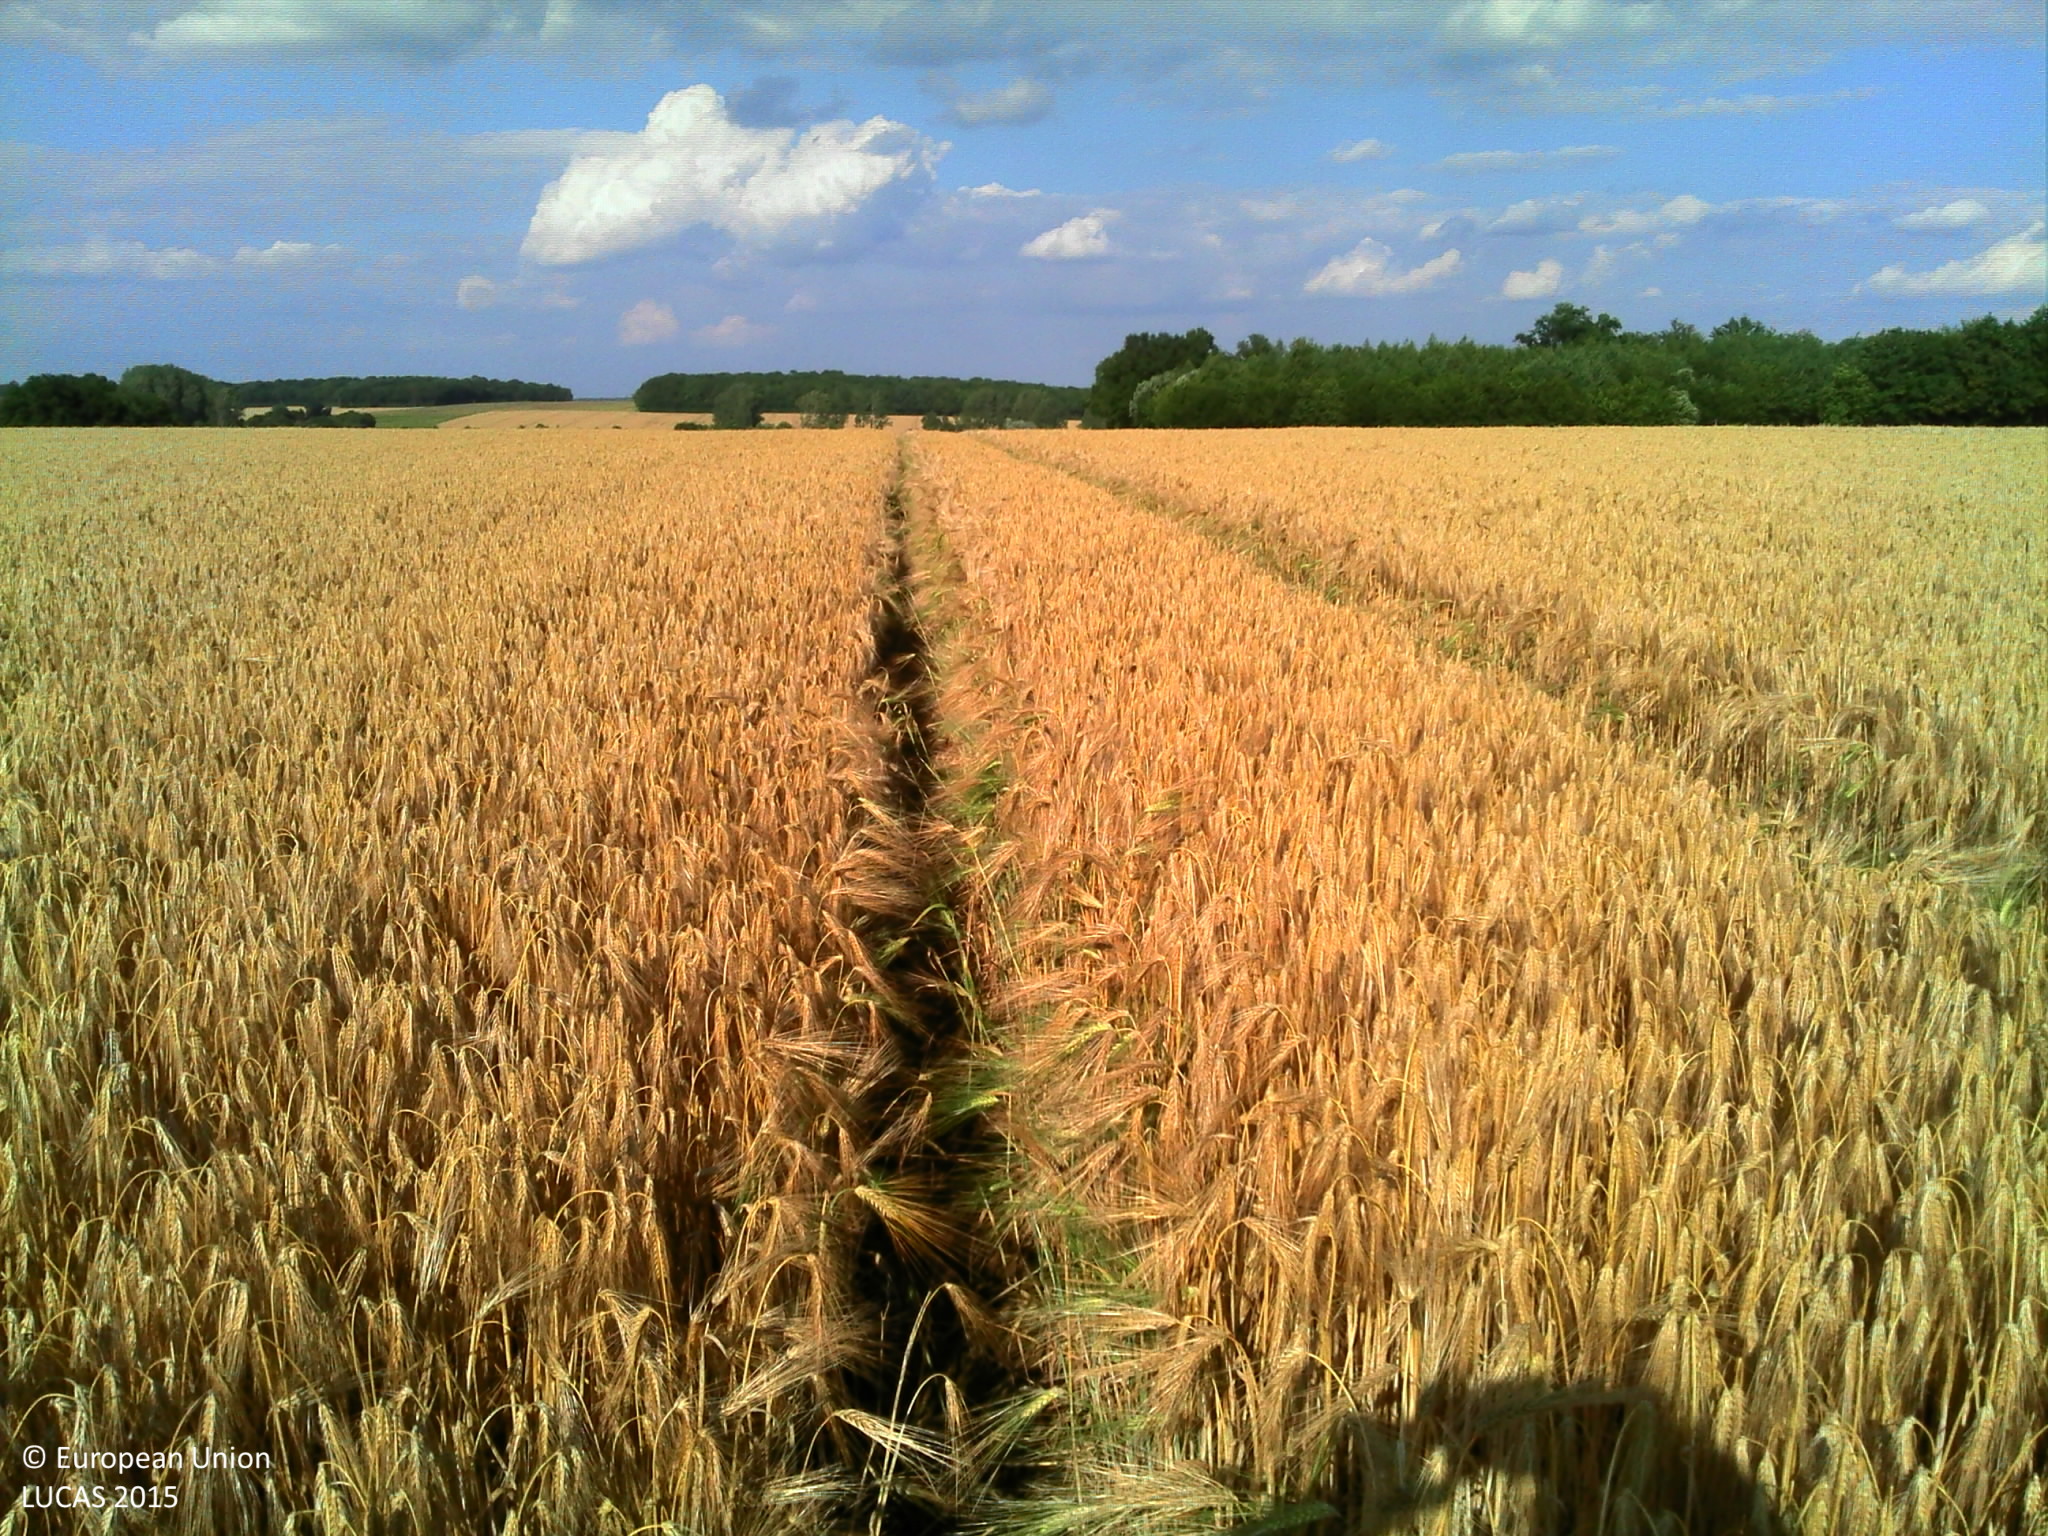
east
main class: Cropland
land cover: Barley
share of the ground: > 75 %
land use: Agriculture (excluding fallow land and kitchen gardens)
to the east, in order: Barley; Electric lines; Ditches and canals; Grass margins; Paved roads, cycling and walking lanes; Grass margins; Common wheat
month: June
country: FR
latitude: 47.3977
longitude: 3.1717
